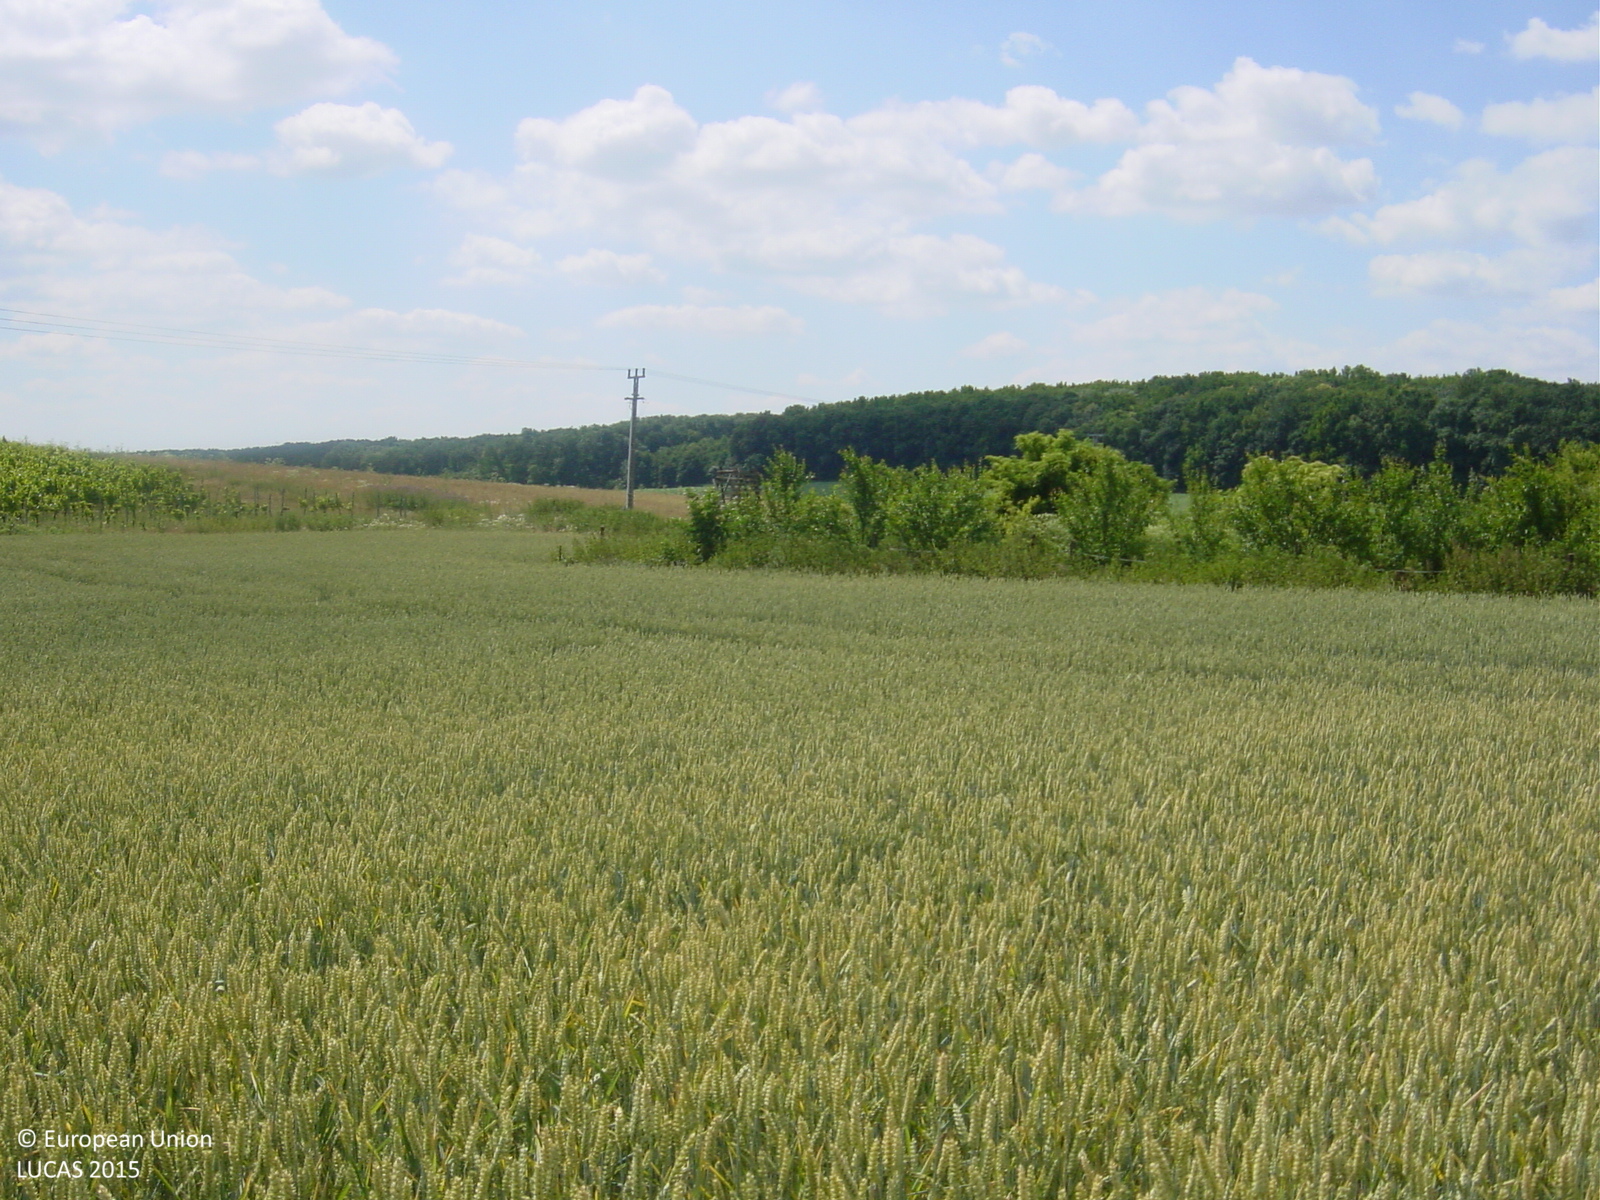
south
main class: Cropland
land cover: Common wheat
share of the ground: > 75 %
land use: Agriculture (excluding fallow land and kitchen gardens)
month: June
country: CZ
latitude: 48.8676
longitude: 17.0023
